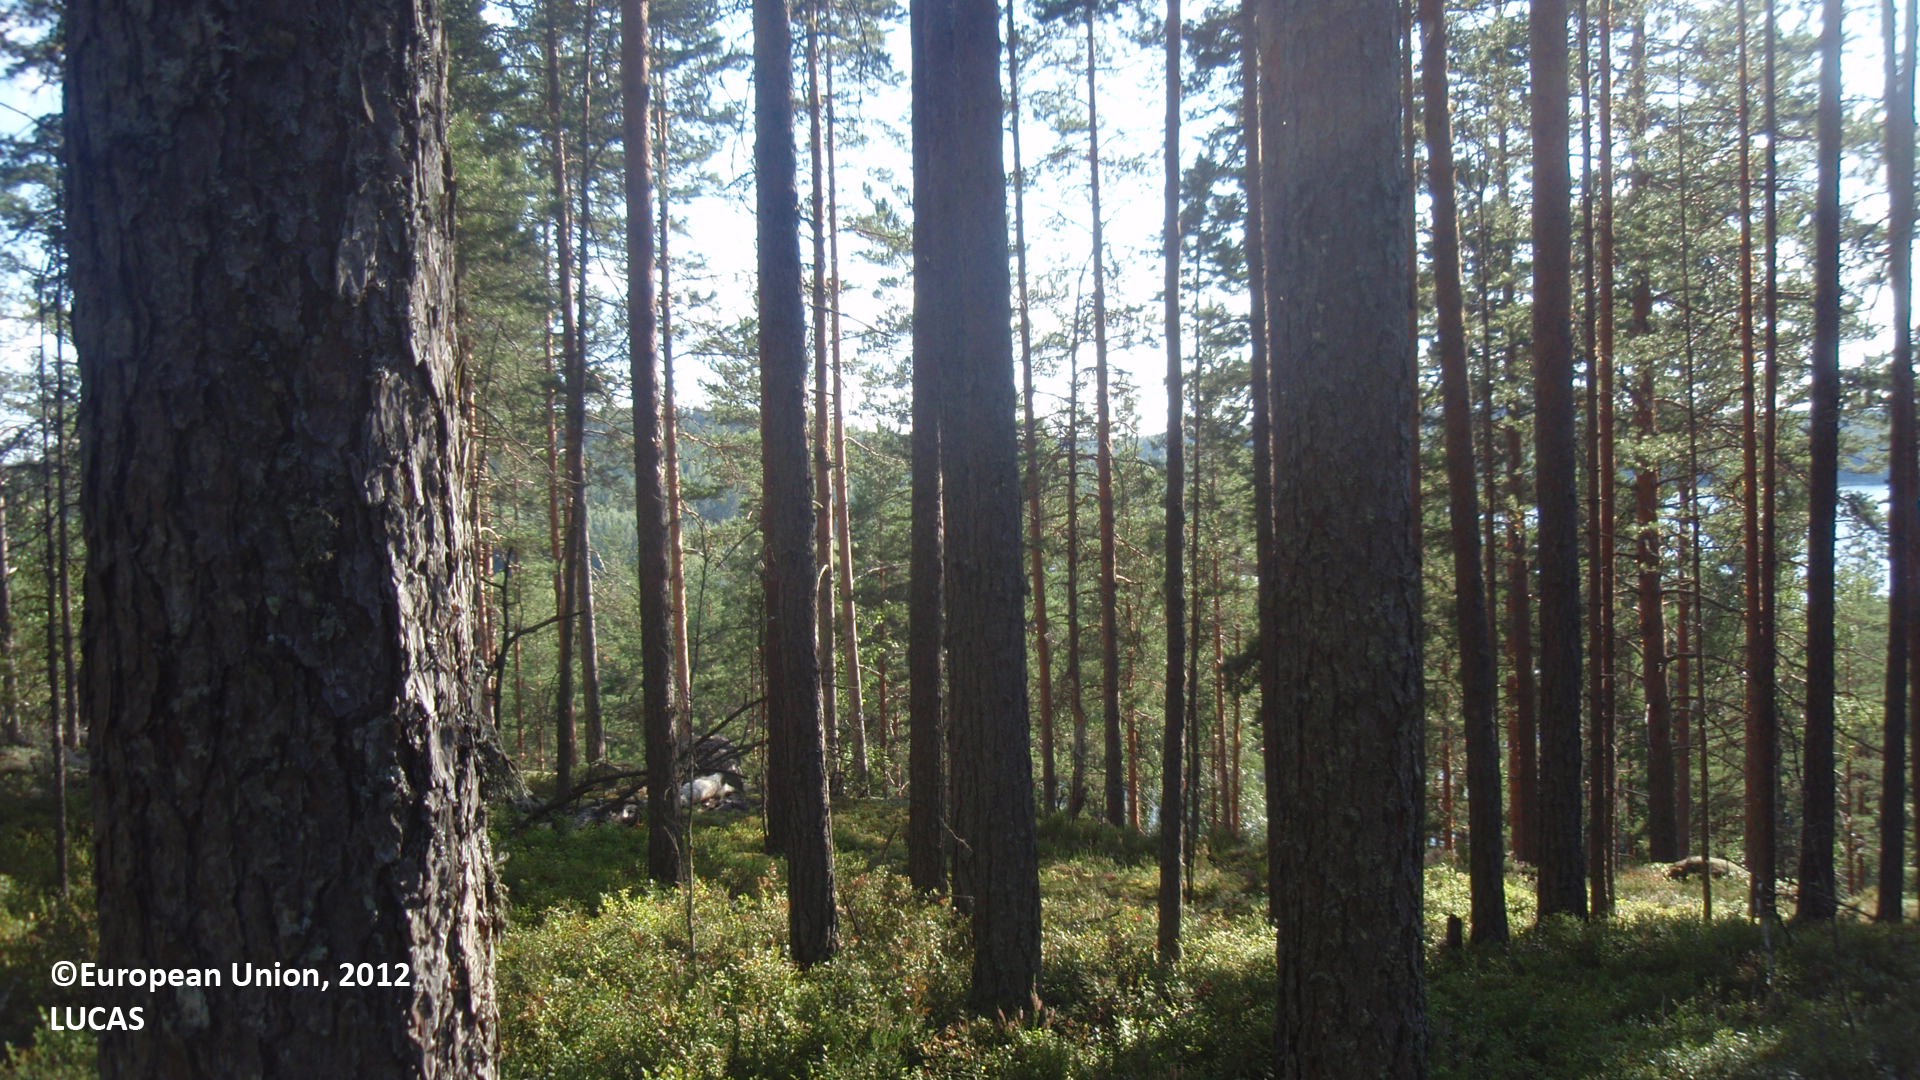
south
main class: Woodland
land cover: Pine dominated coniferous woodland
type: boreal forest
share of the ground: 50 - 75 %
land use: Forestry
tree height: > 5 m
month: August
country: FI
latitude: 61.5578
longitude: 27.7846
